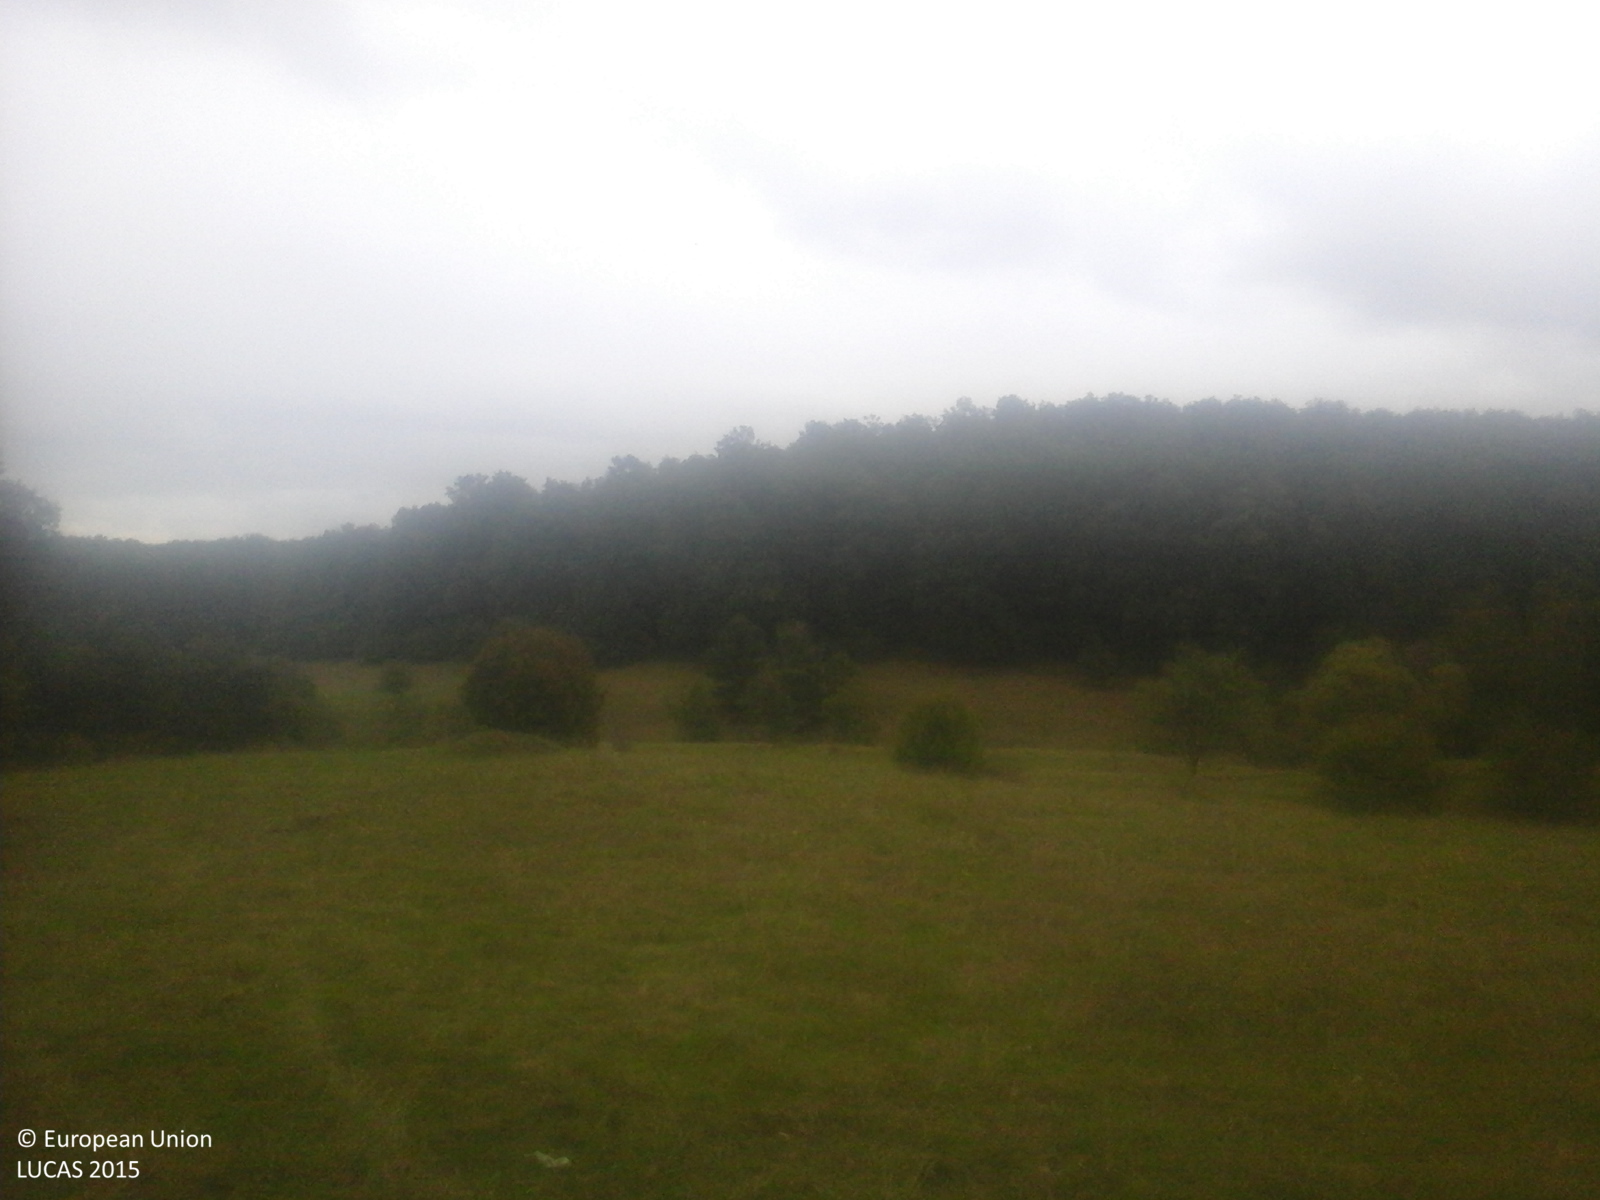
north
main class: Grassland
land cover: Grassland without tree/shrub cover
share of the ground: > 75 %
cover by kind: herbaceous plants 100 %
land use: Agriculture (excluding fallow land and kitchen gardens)
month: September
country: RO
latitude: 45.9190
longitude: 23.4335
